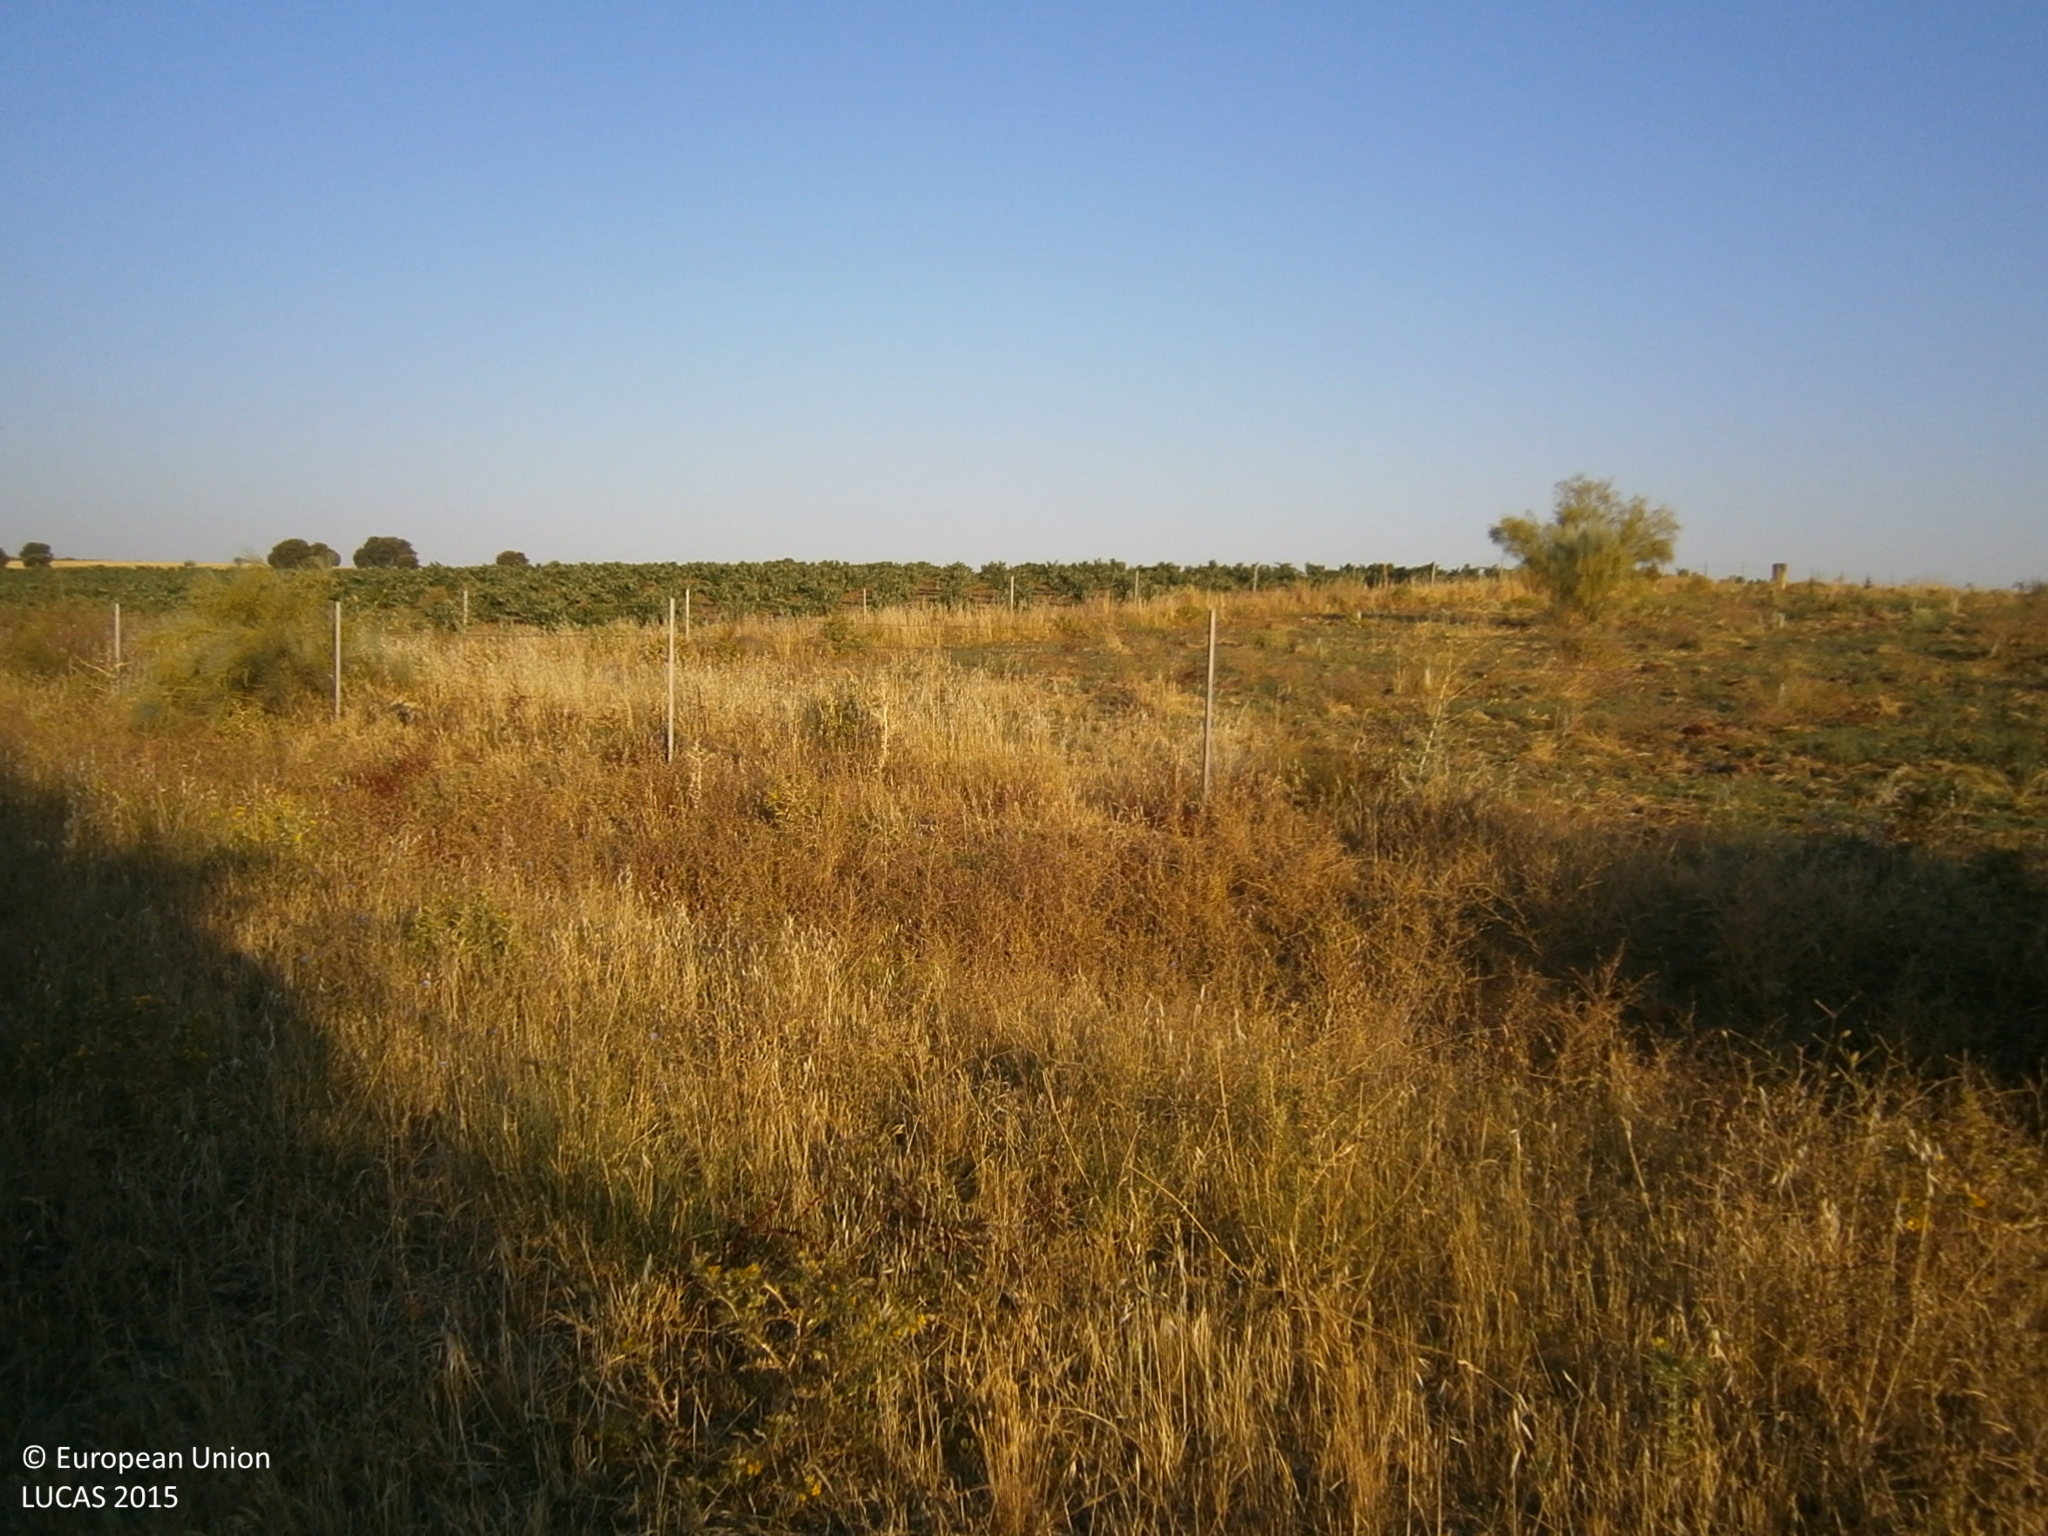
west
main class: Grassland
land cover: Spontaneously vegetated surfaces
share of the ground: > 75 %
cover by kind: herbaceous plants 95 %, unconsolidated bare surface 5 %
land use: Abandoned areas
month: June
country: ES
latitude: 38.6447
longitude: -6.7786
